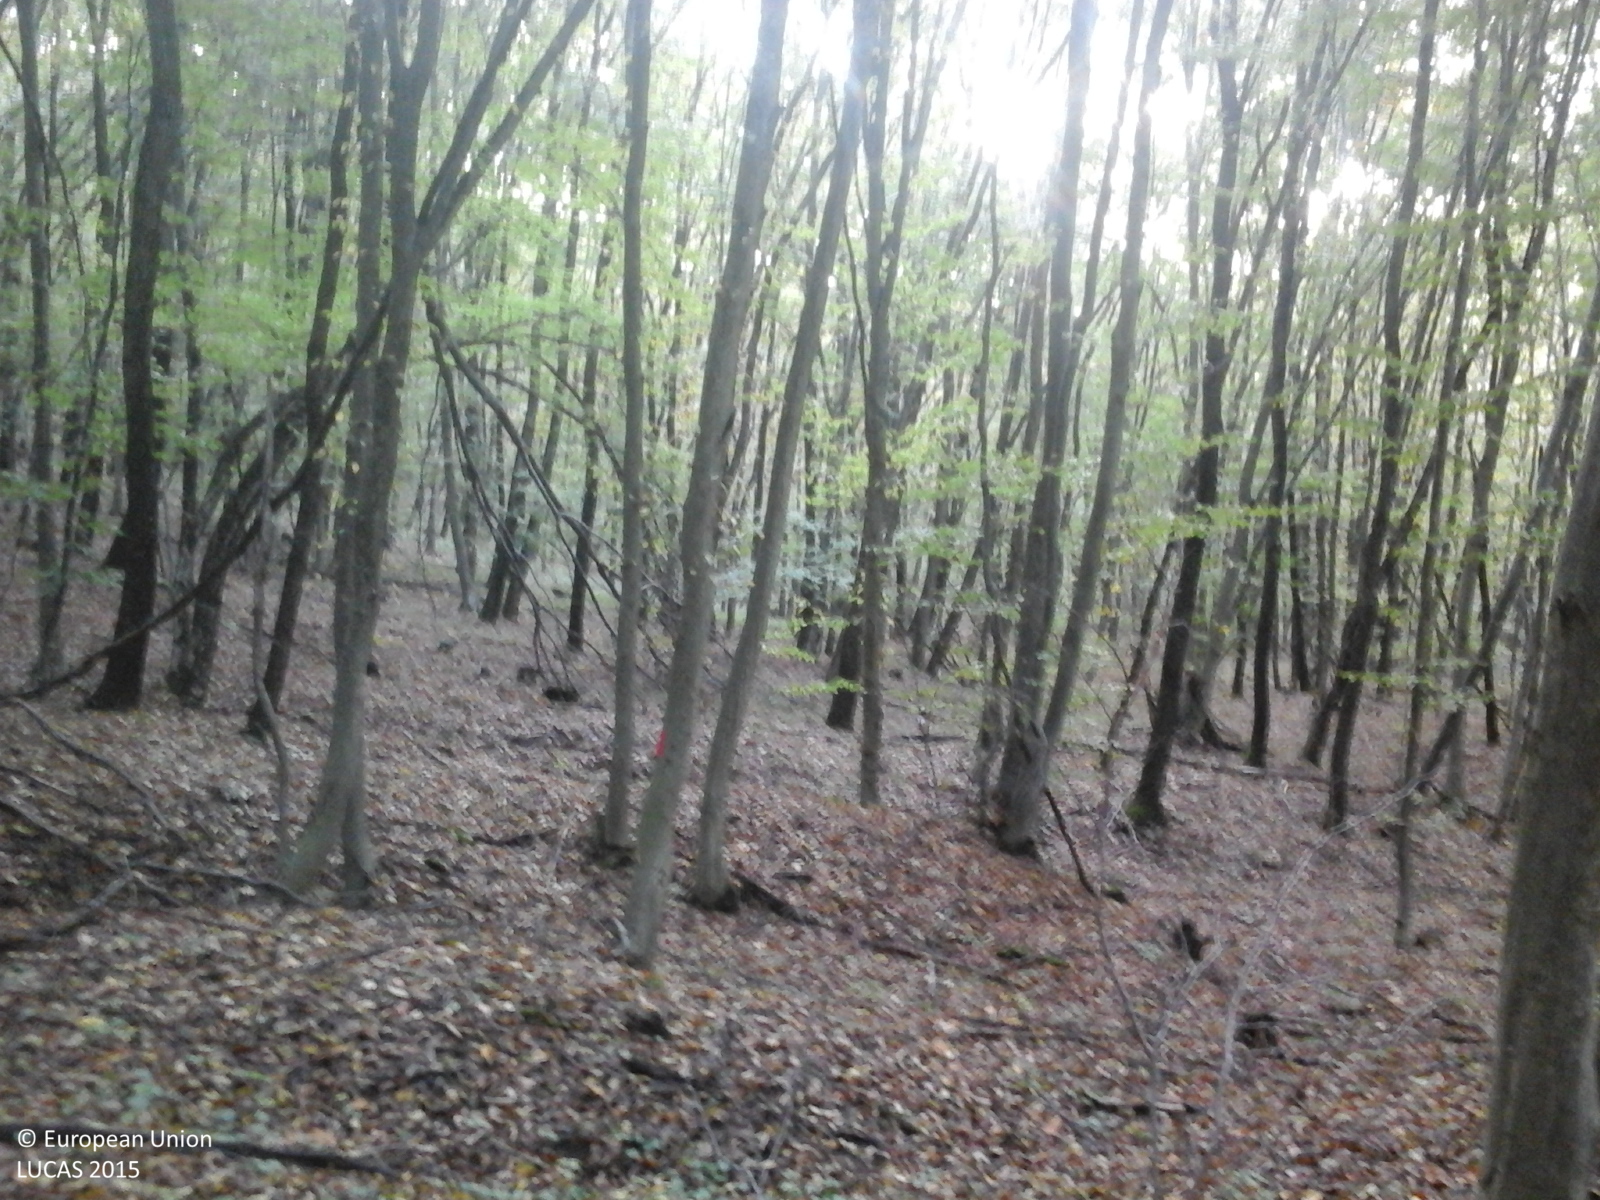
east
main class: Woodland
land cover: Broadleaved woodland
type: beech forest
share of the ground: > 75 %
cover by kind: broadleaved forest trees 100 %
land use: Forestry
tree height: > 5 m
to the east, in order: Broadleaved woodland
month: October
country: RO
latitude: 45.8964
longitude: 25.0840
